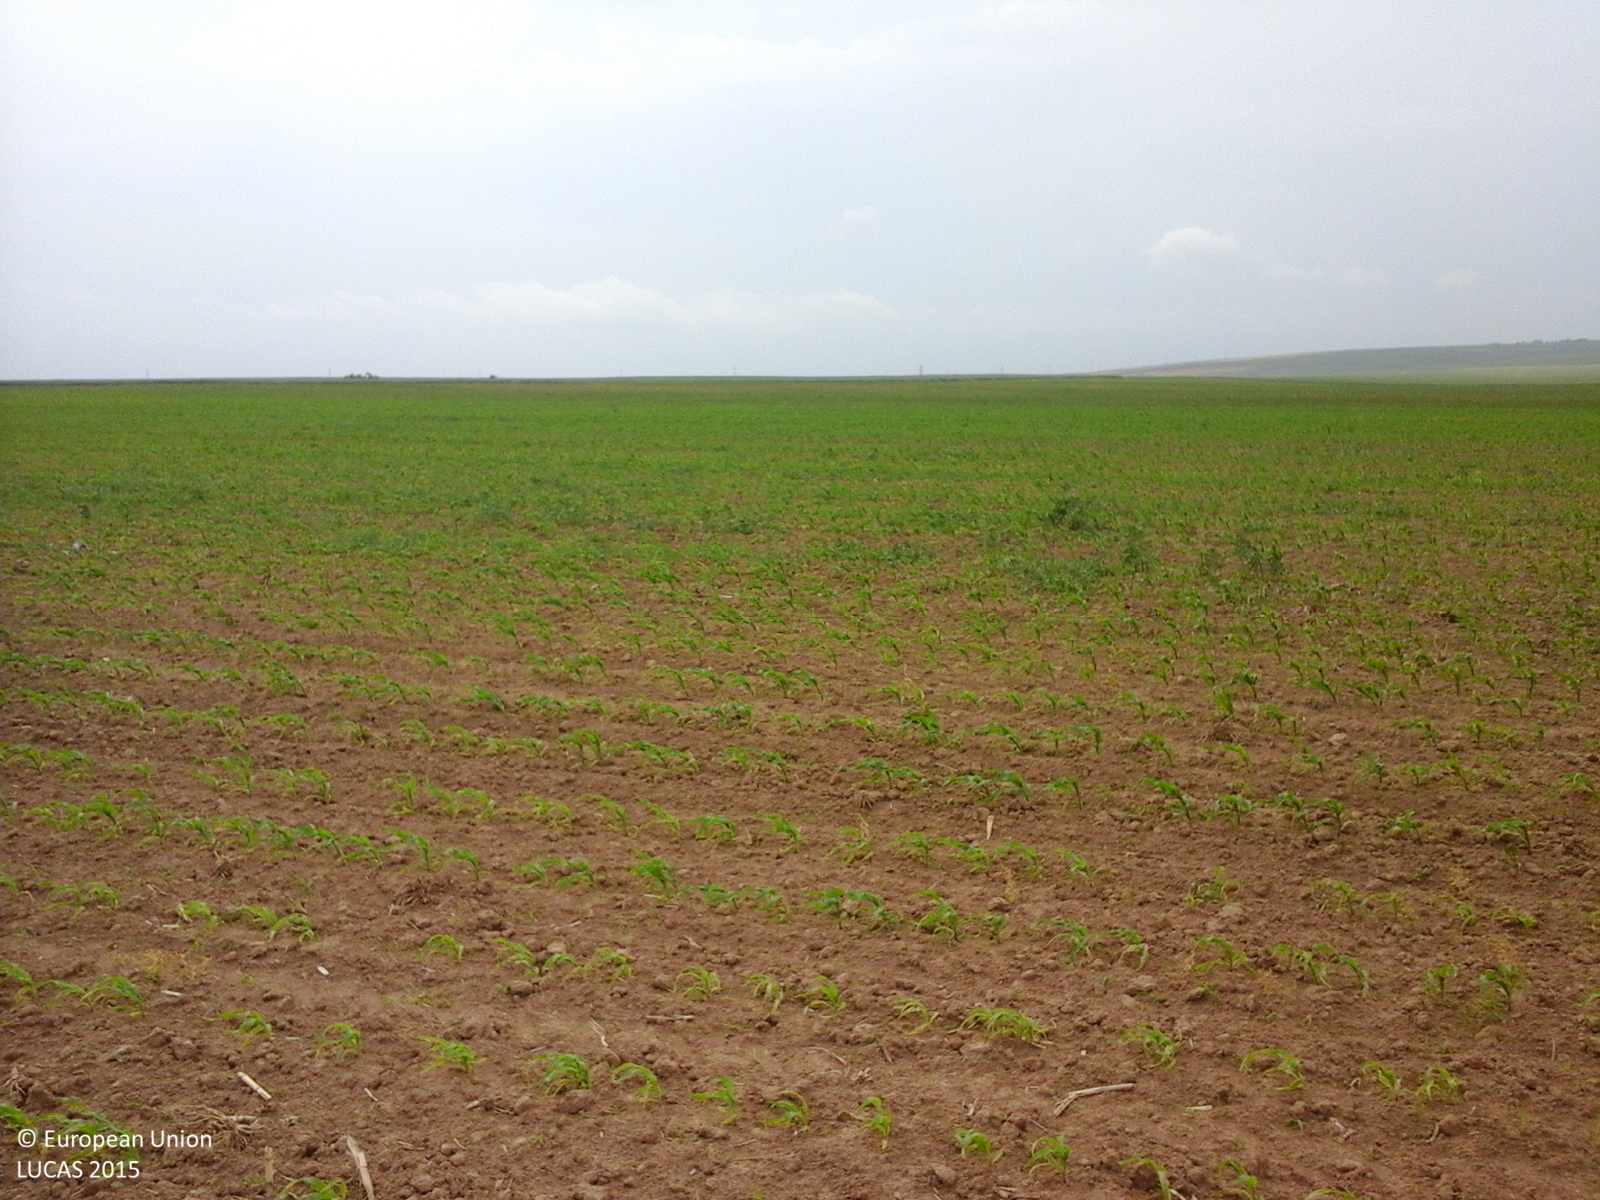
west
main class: Cropland
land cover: Maize
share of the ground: 25 - 50 %
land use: Agriculture (excluding fallow land and kitchen gardens)
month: June
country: RO
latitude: 47.0938
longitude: 26.7587
